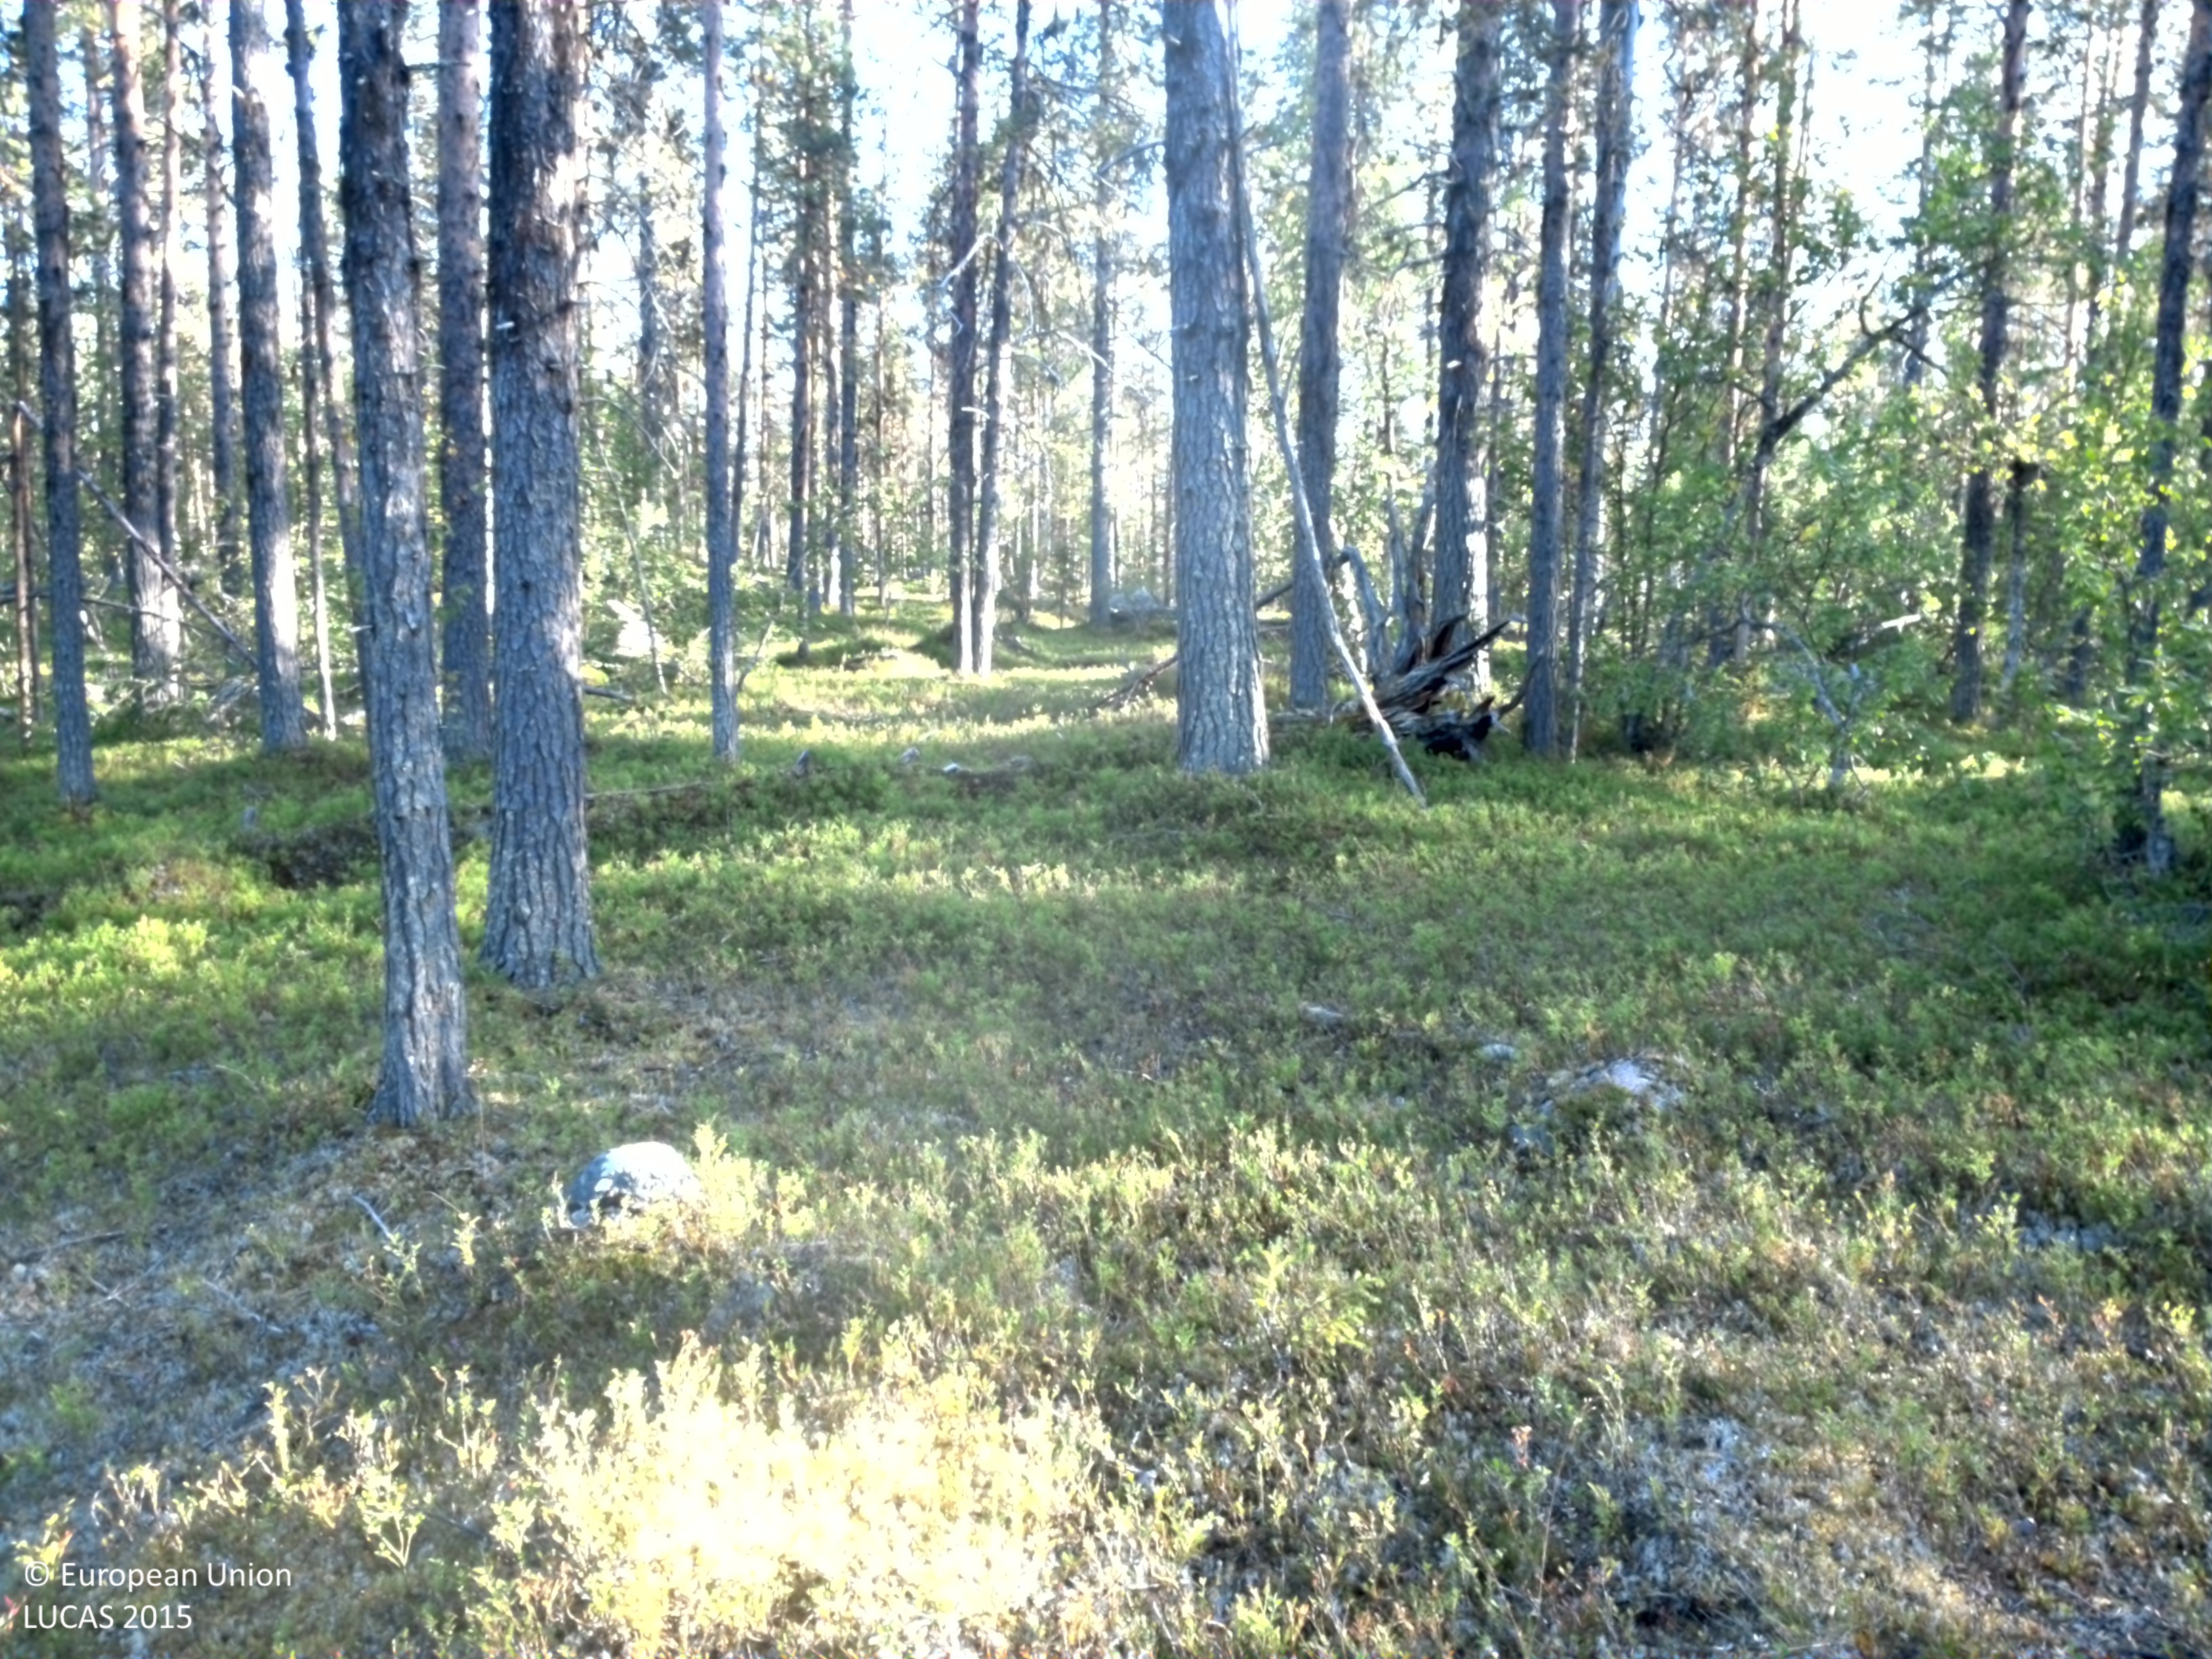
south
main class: Woodland
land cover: Pine dominated coniferous woodland
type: boreal forest
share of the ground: 25 - 50 %
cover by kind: shrubs 55 %, coniferous forest trees 35 %, broadleaved forest trees 5 %, lichens and mosses 5 %
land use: Forestry
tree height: > 5 m
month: August
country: SE
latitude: 66.9130
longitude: 18.9743
